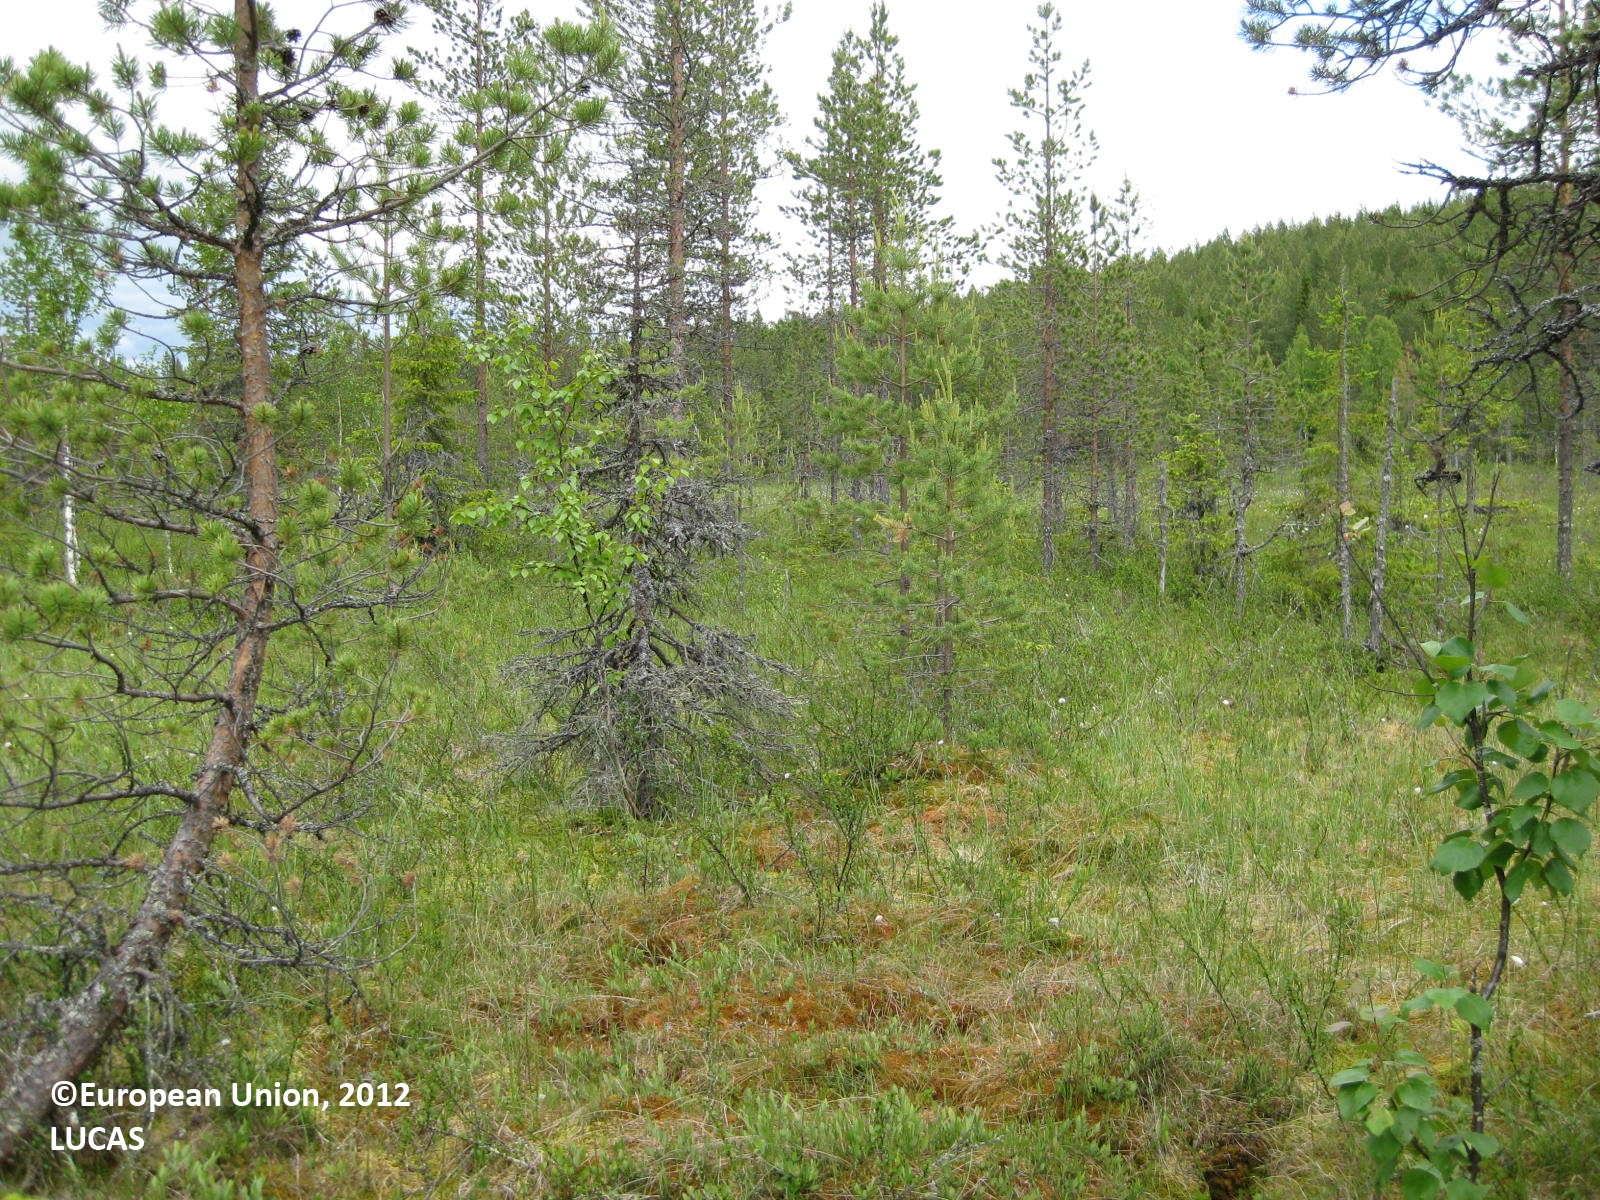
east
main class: Woodland
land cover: Pine dominated coniferous woodland
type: boreal forest
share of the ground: 50 - 75 %
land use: Semi-natural and natural areas not in use
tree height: > 5 m
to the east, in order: Pine dominated coniferous woodland; Pine dominated mixed woodland; Shrubland without tree cover; Tracks; Other mixed woodland
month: June
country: FI
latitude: 65.3224
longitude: 28.2512
